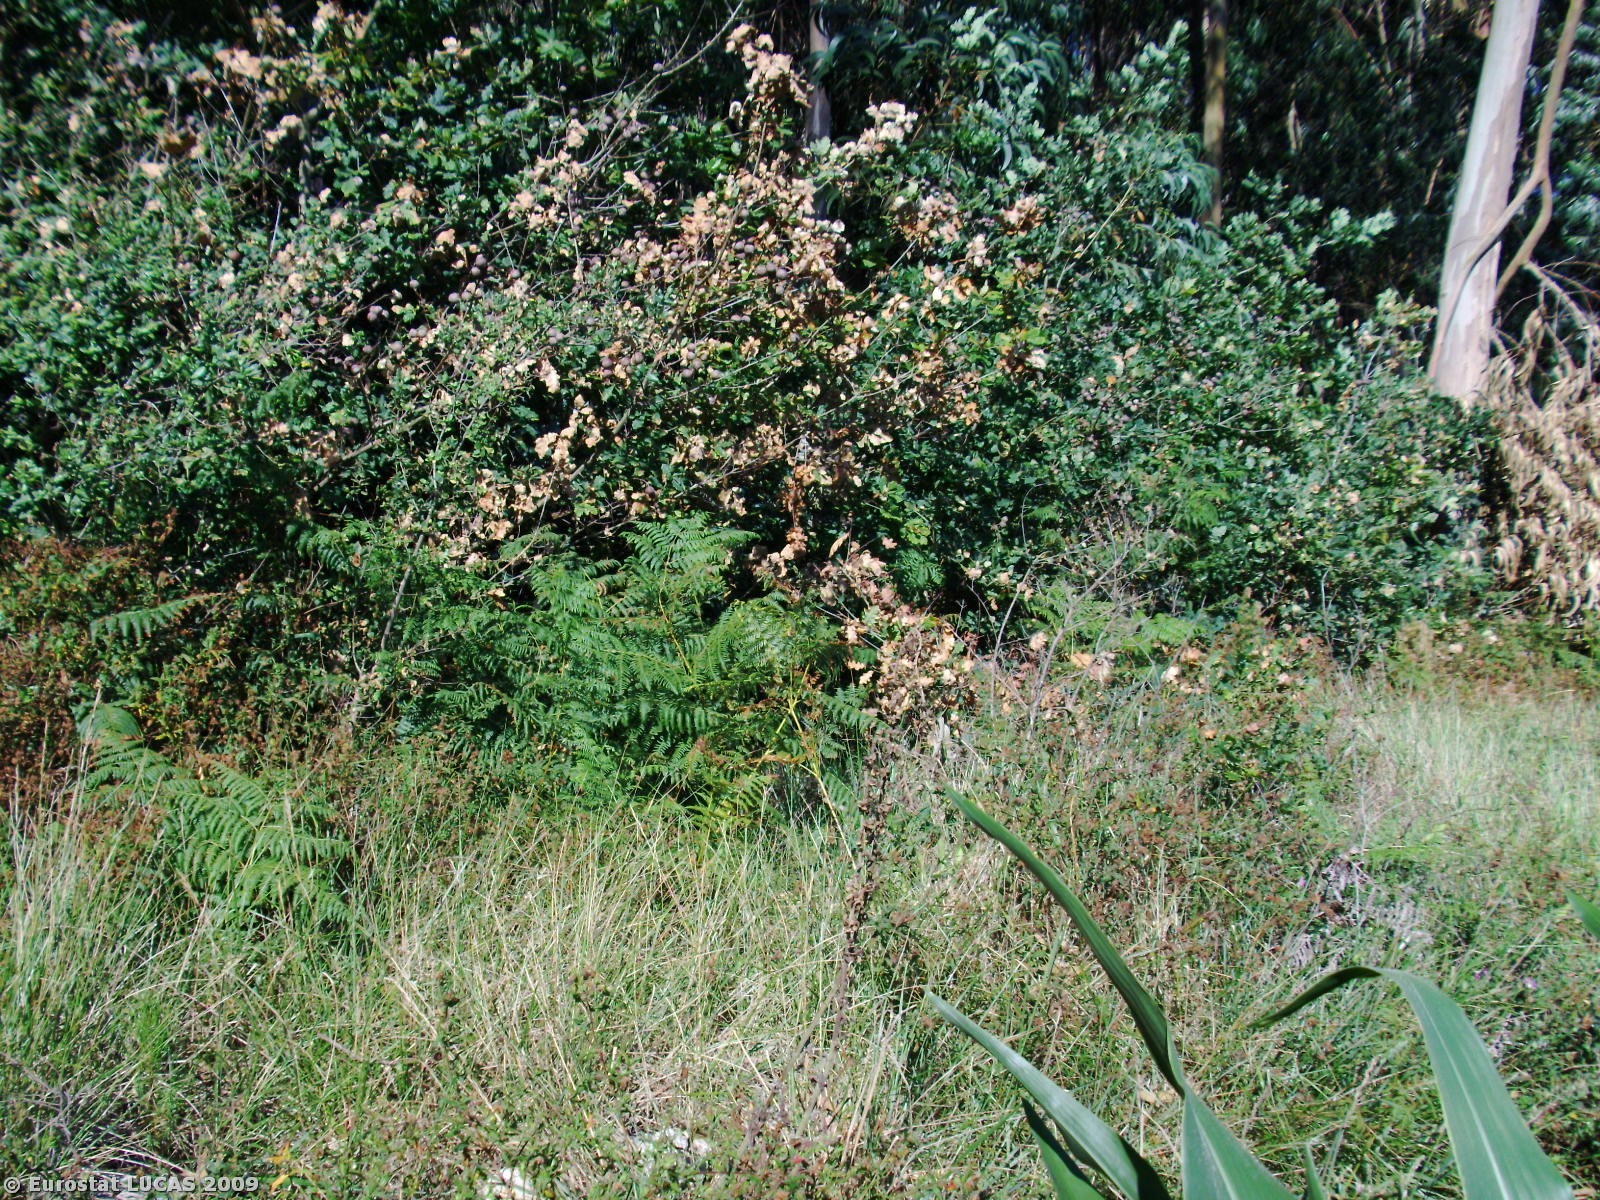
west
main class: Cropland
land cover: Maize
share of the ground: > 75 %
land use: Agriculture (excluding fallow land and kitchen gardens)
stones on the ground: < 10 %
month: June
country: PT
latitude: 41.3610
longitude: -8.6748
